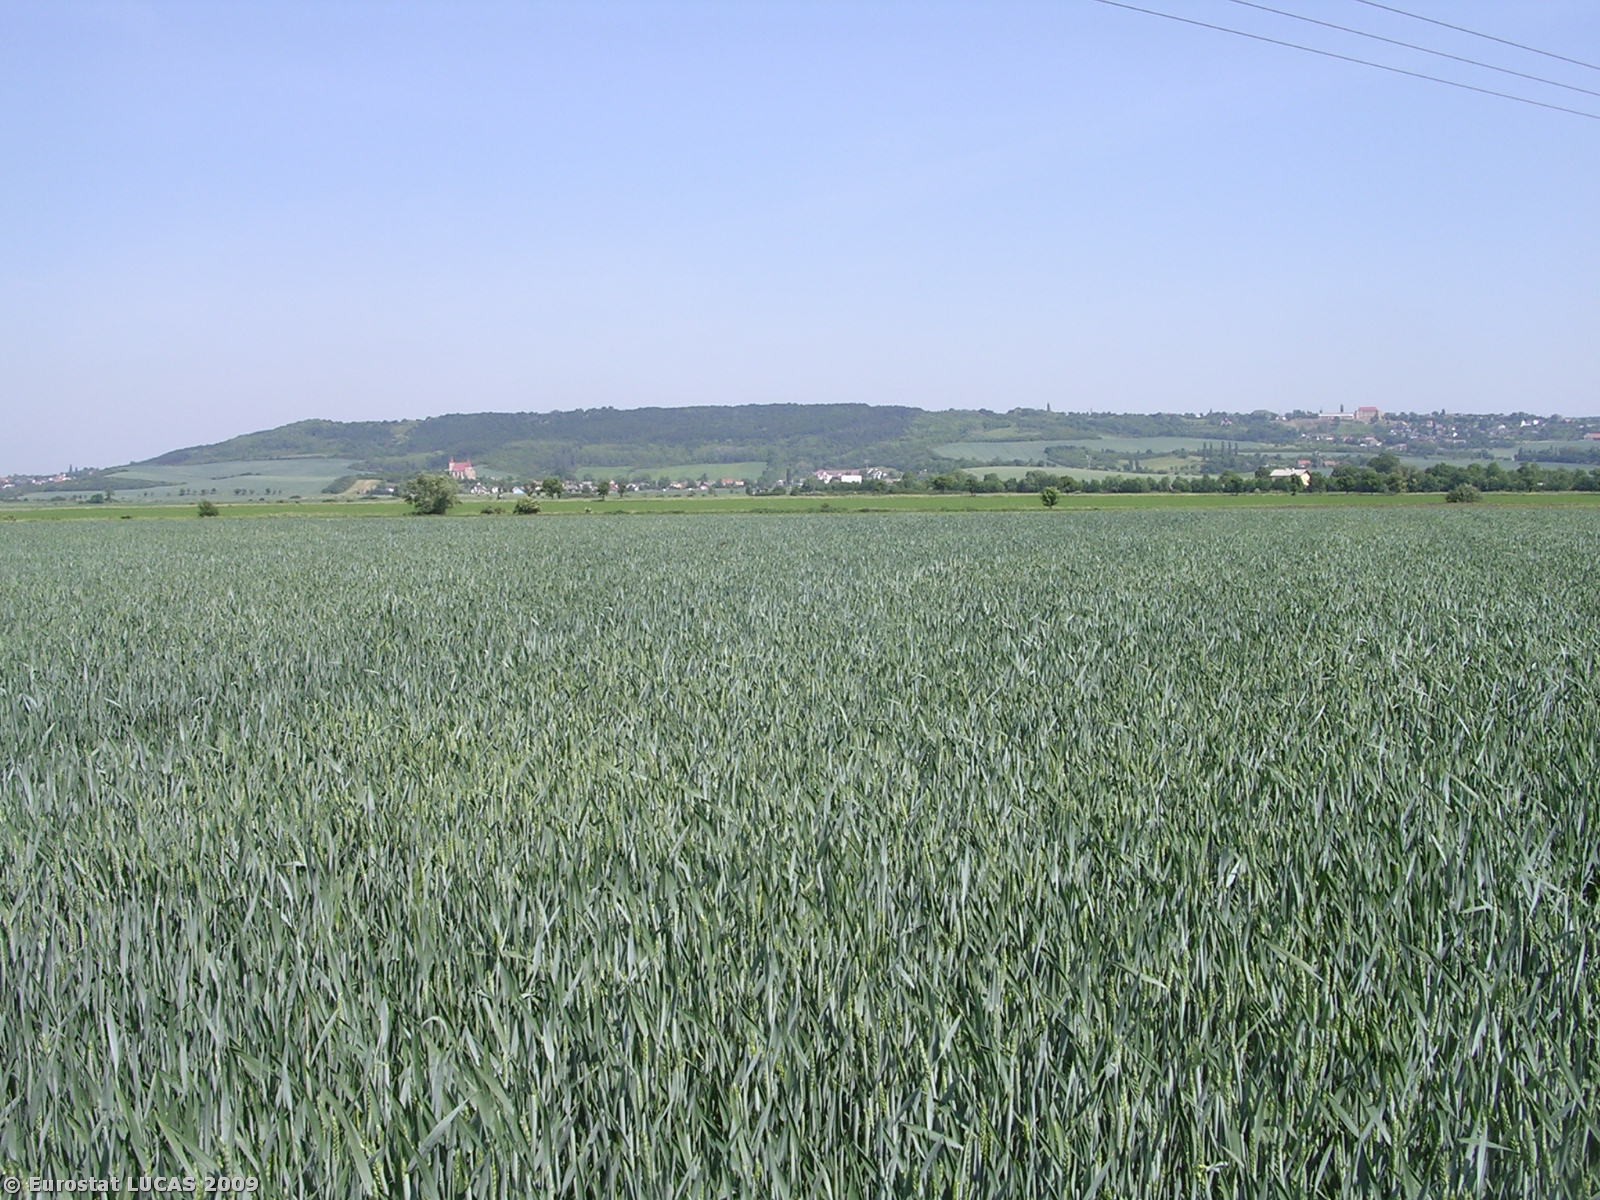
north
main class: Cropland
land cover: Common wheat
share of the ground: > 75 %
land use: Agriculture (excluding fallow land and kitchen gardens)
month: May
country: CZ
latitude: 50.3477
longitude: 14.9353
